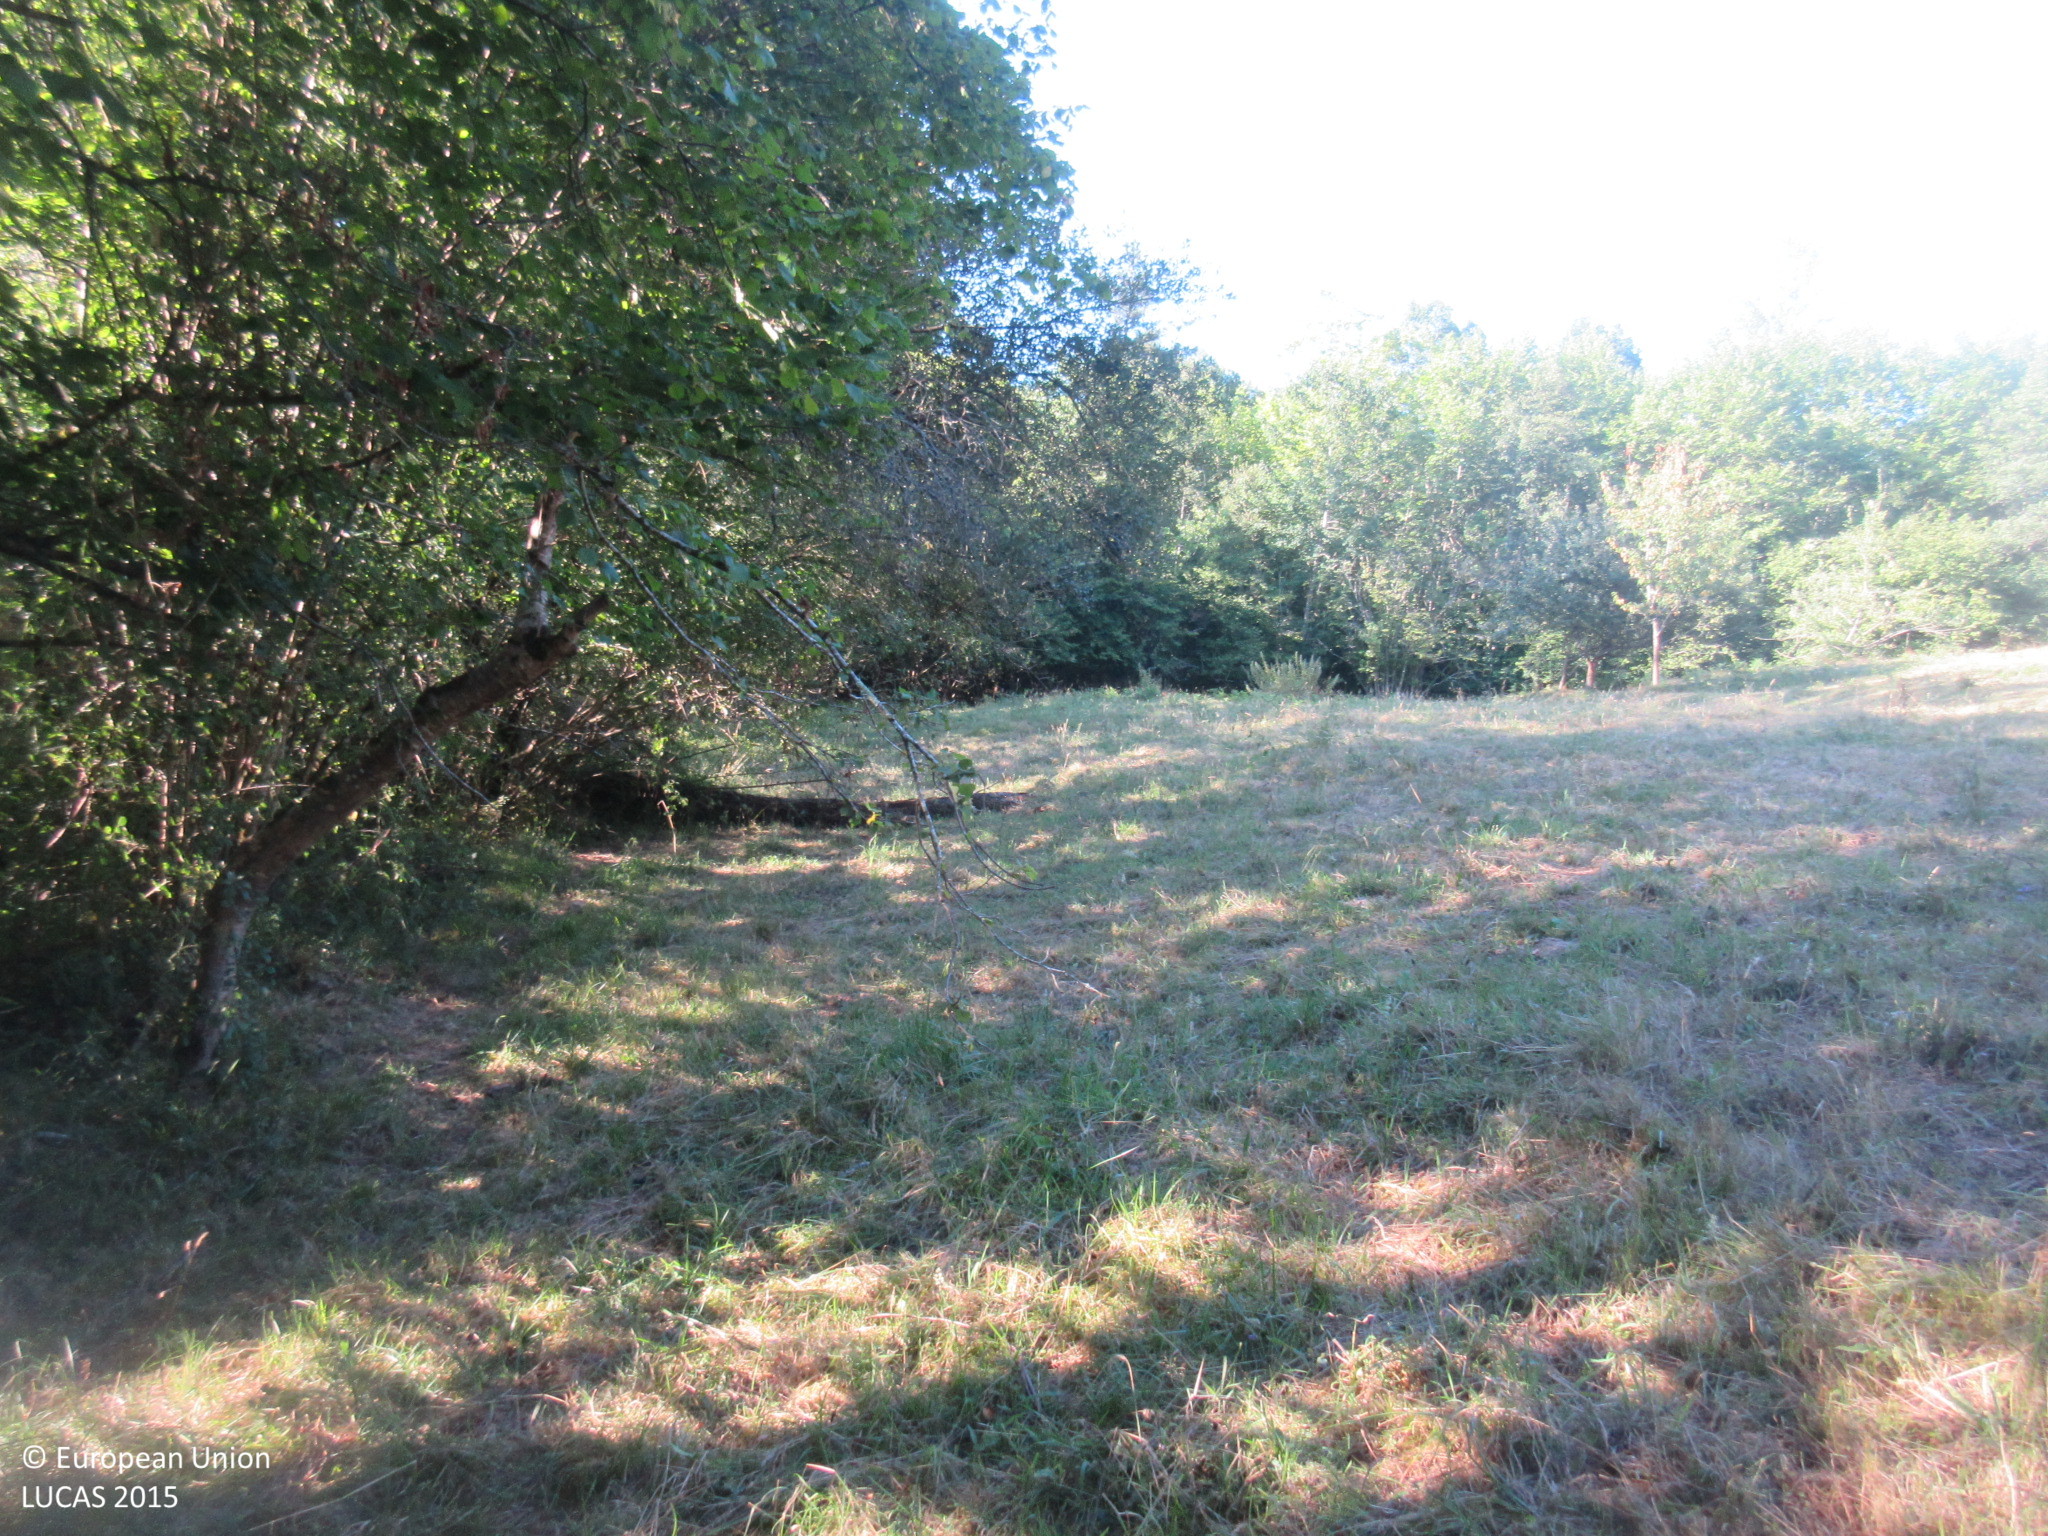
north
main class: Grassland
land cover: Grassland without tree/shrub cover
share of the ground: > 75 %
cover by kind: herbaceous plants 100 %
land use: Agriculture (excluding fallow land and kitchen gardens)
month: July
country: ES
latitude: 43.3537
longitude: -5.0612
